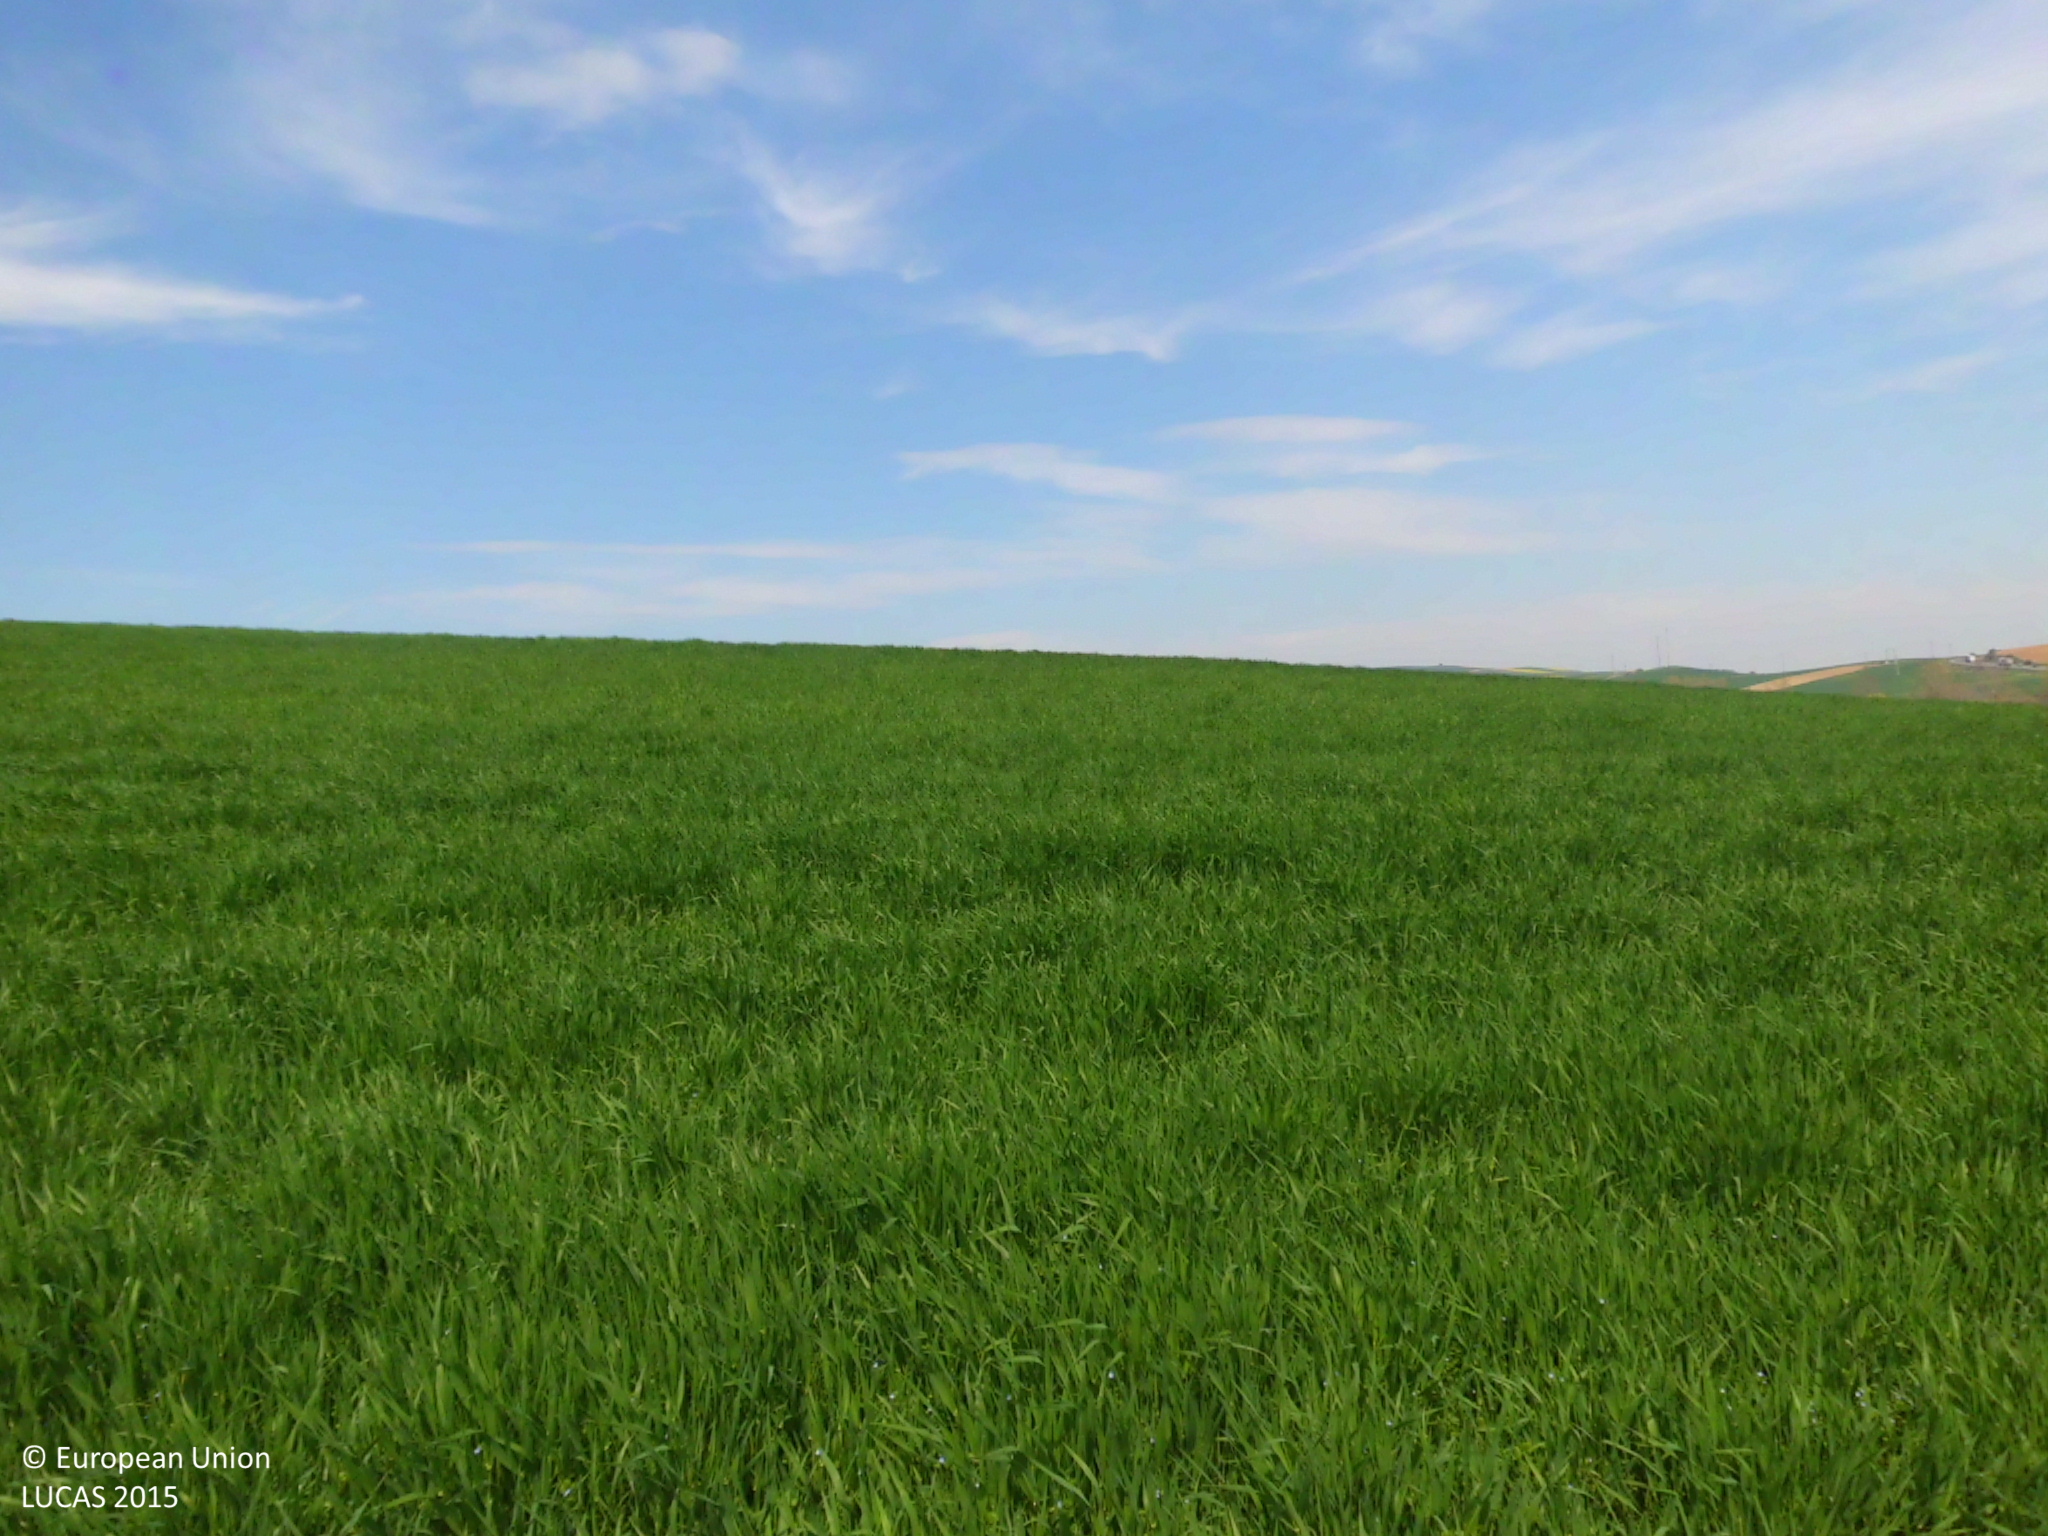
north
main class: Cropland
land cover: Barley
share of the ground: > 75 %
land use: Agriculture (excluding fallow land and kitchen gardens)
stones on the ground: < 10 %
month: April
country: ES
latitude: 42.3929
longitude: -3.3086
